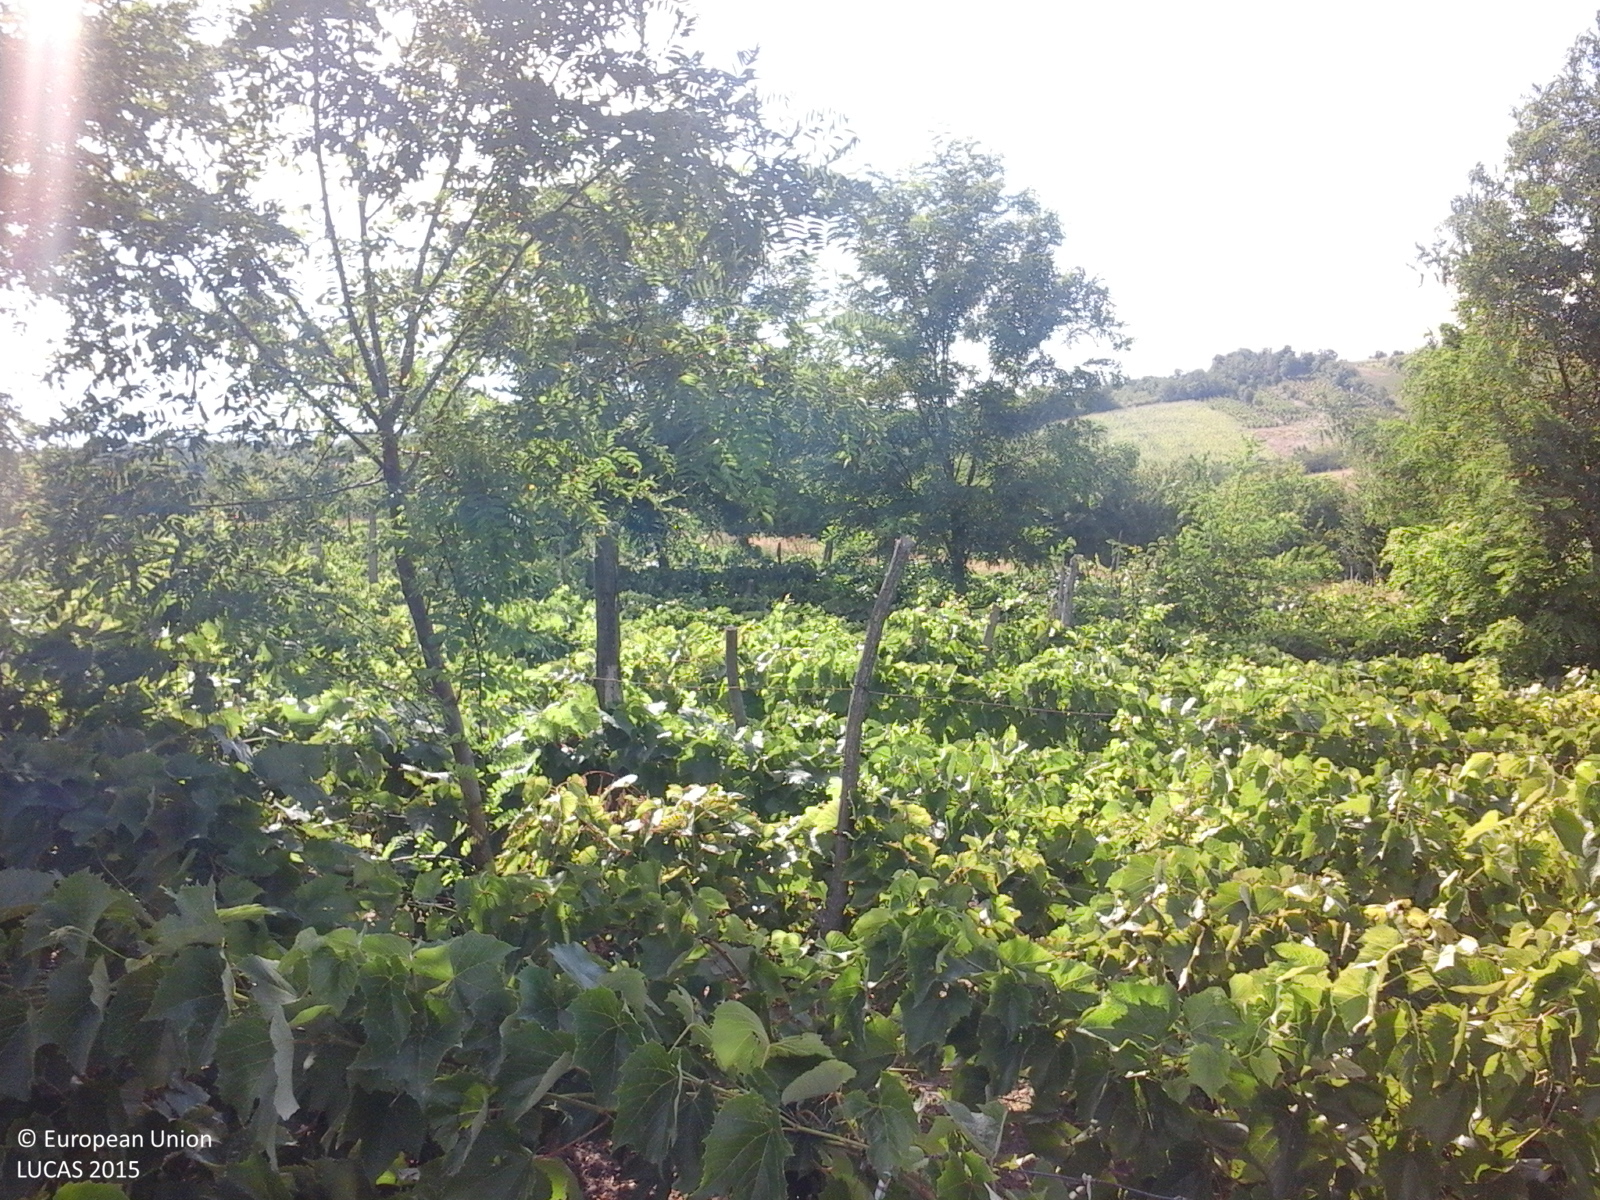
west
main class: Cropland
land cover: Vineyards
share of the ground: > 75 %
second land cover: Grassland without tree/shrub cover
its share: > 75 %
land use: Agriculture (excluding fallow land and kitchen gardens)
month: July
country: RO
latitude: 46.0475
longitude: 27.6488
